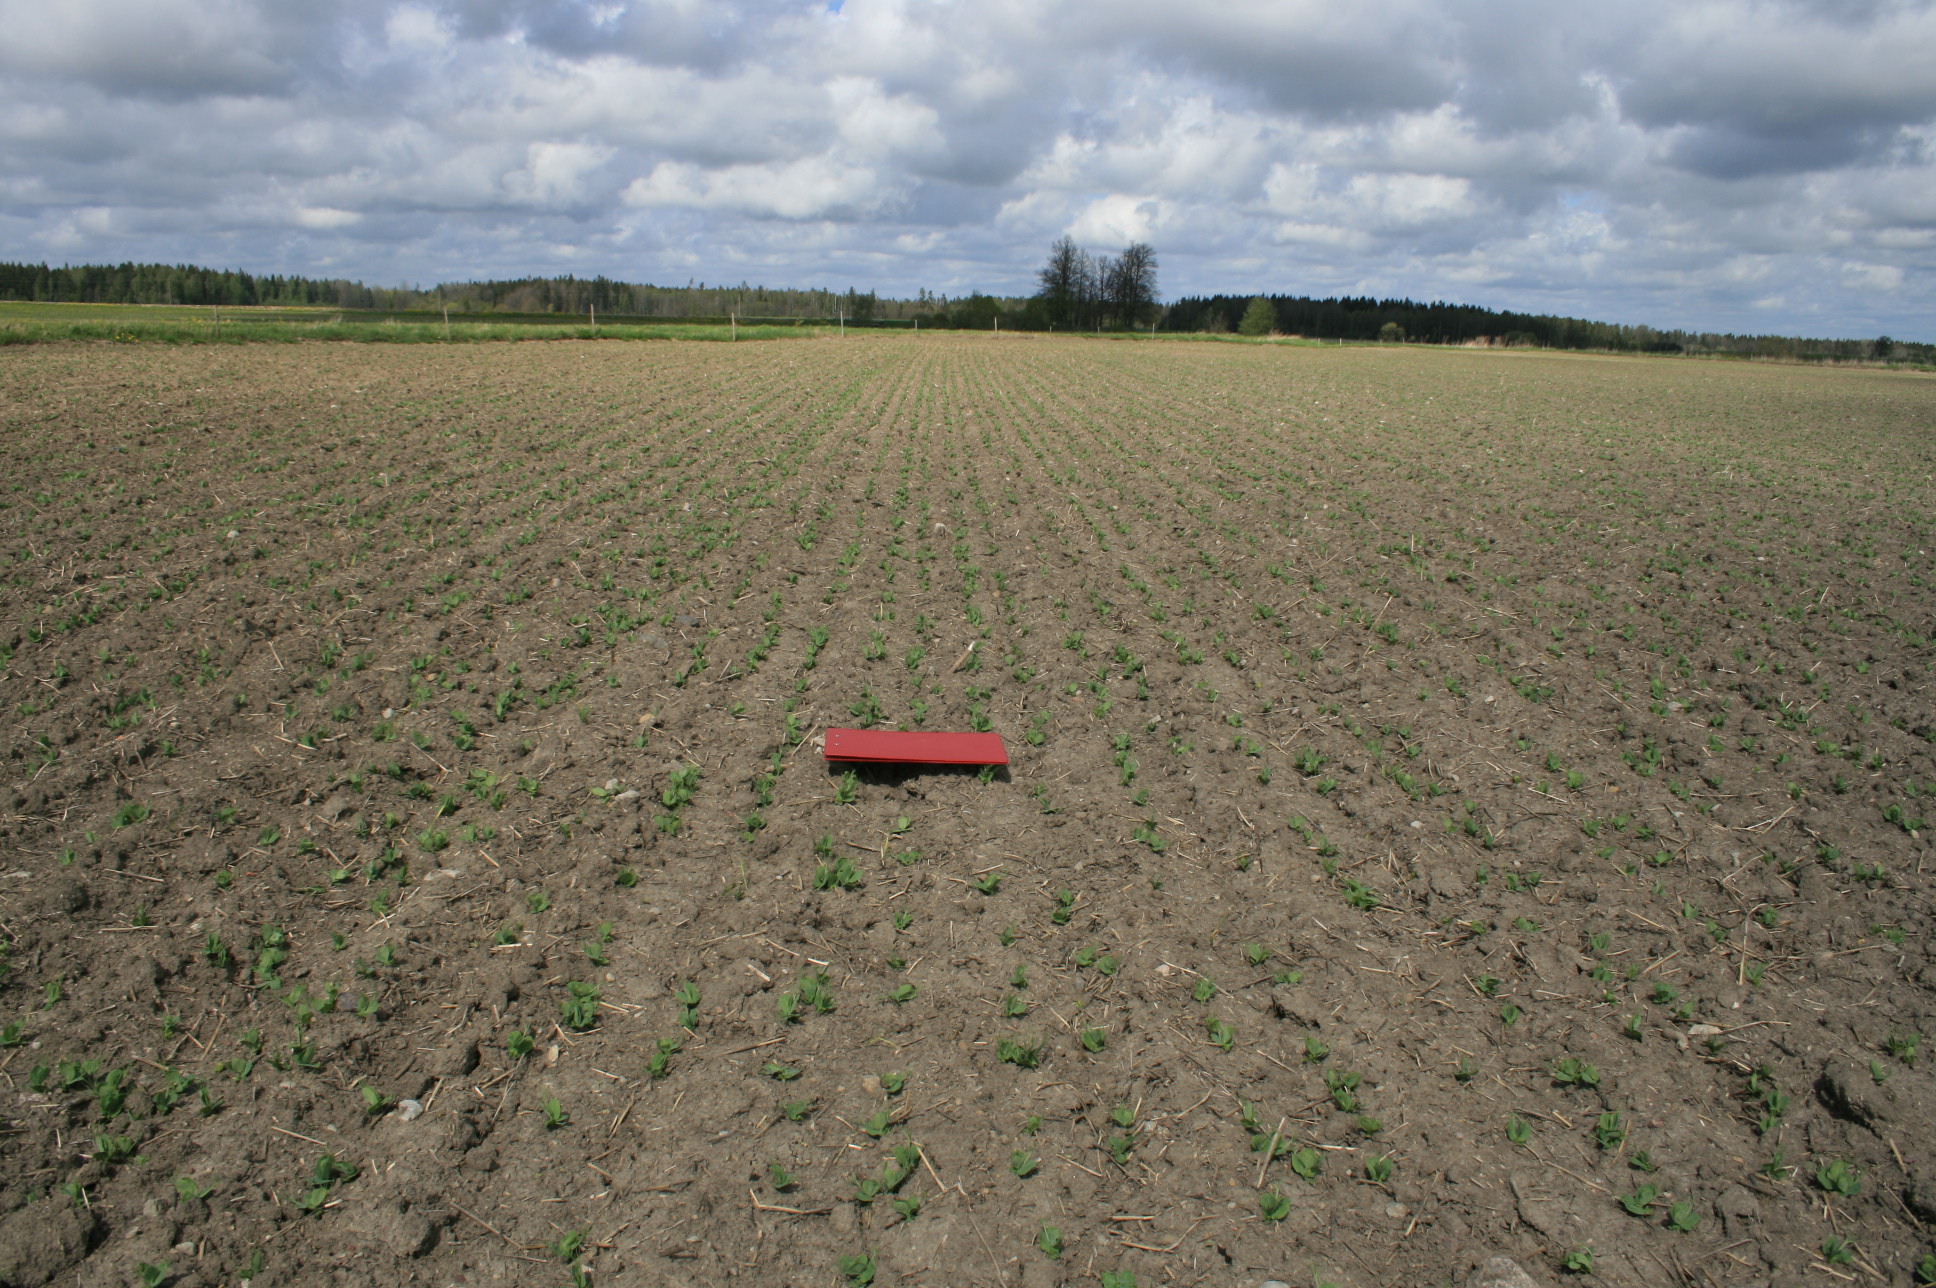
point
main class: Cropland
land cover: Dry pulses
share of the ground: 10 - 25 %
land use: Agriculture (excluding fallow land and kitchen gardens)
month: May
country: LT
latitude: 56.1690
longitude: 21.3962
